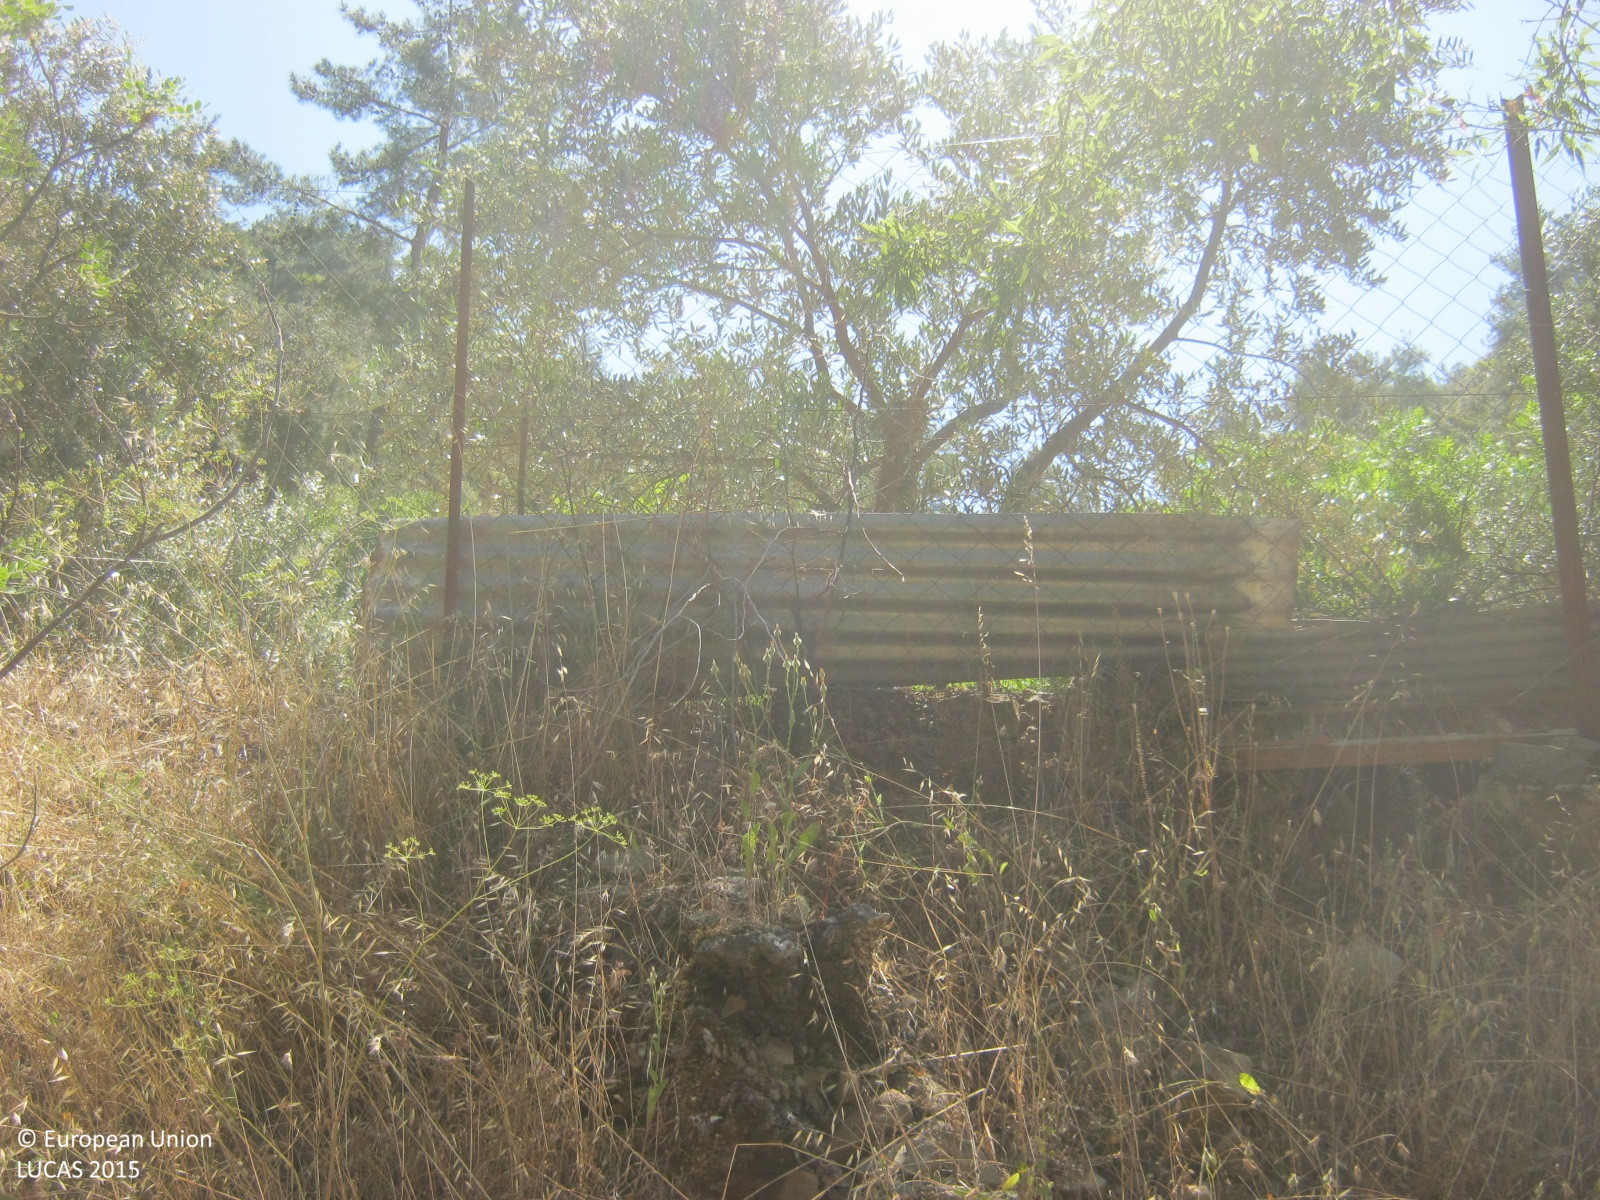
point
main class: Cropland
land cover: Olive groves
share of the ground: 50 - 75 %
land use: Agriculture (excluding fallow land and kitchen gardens)
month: June
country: CY
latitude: 34.9919
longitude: 32.8117
